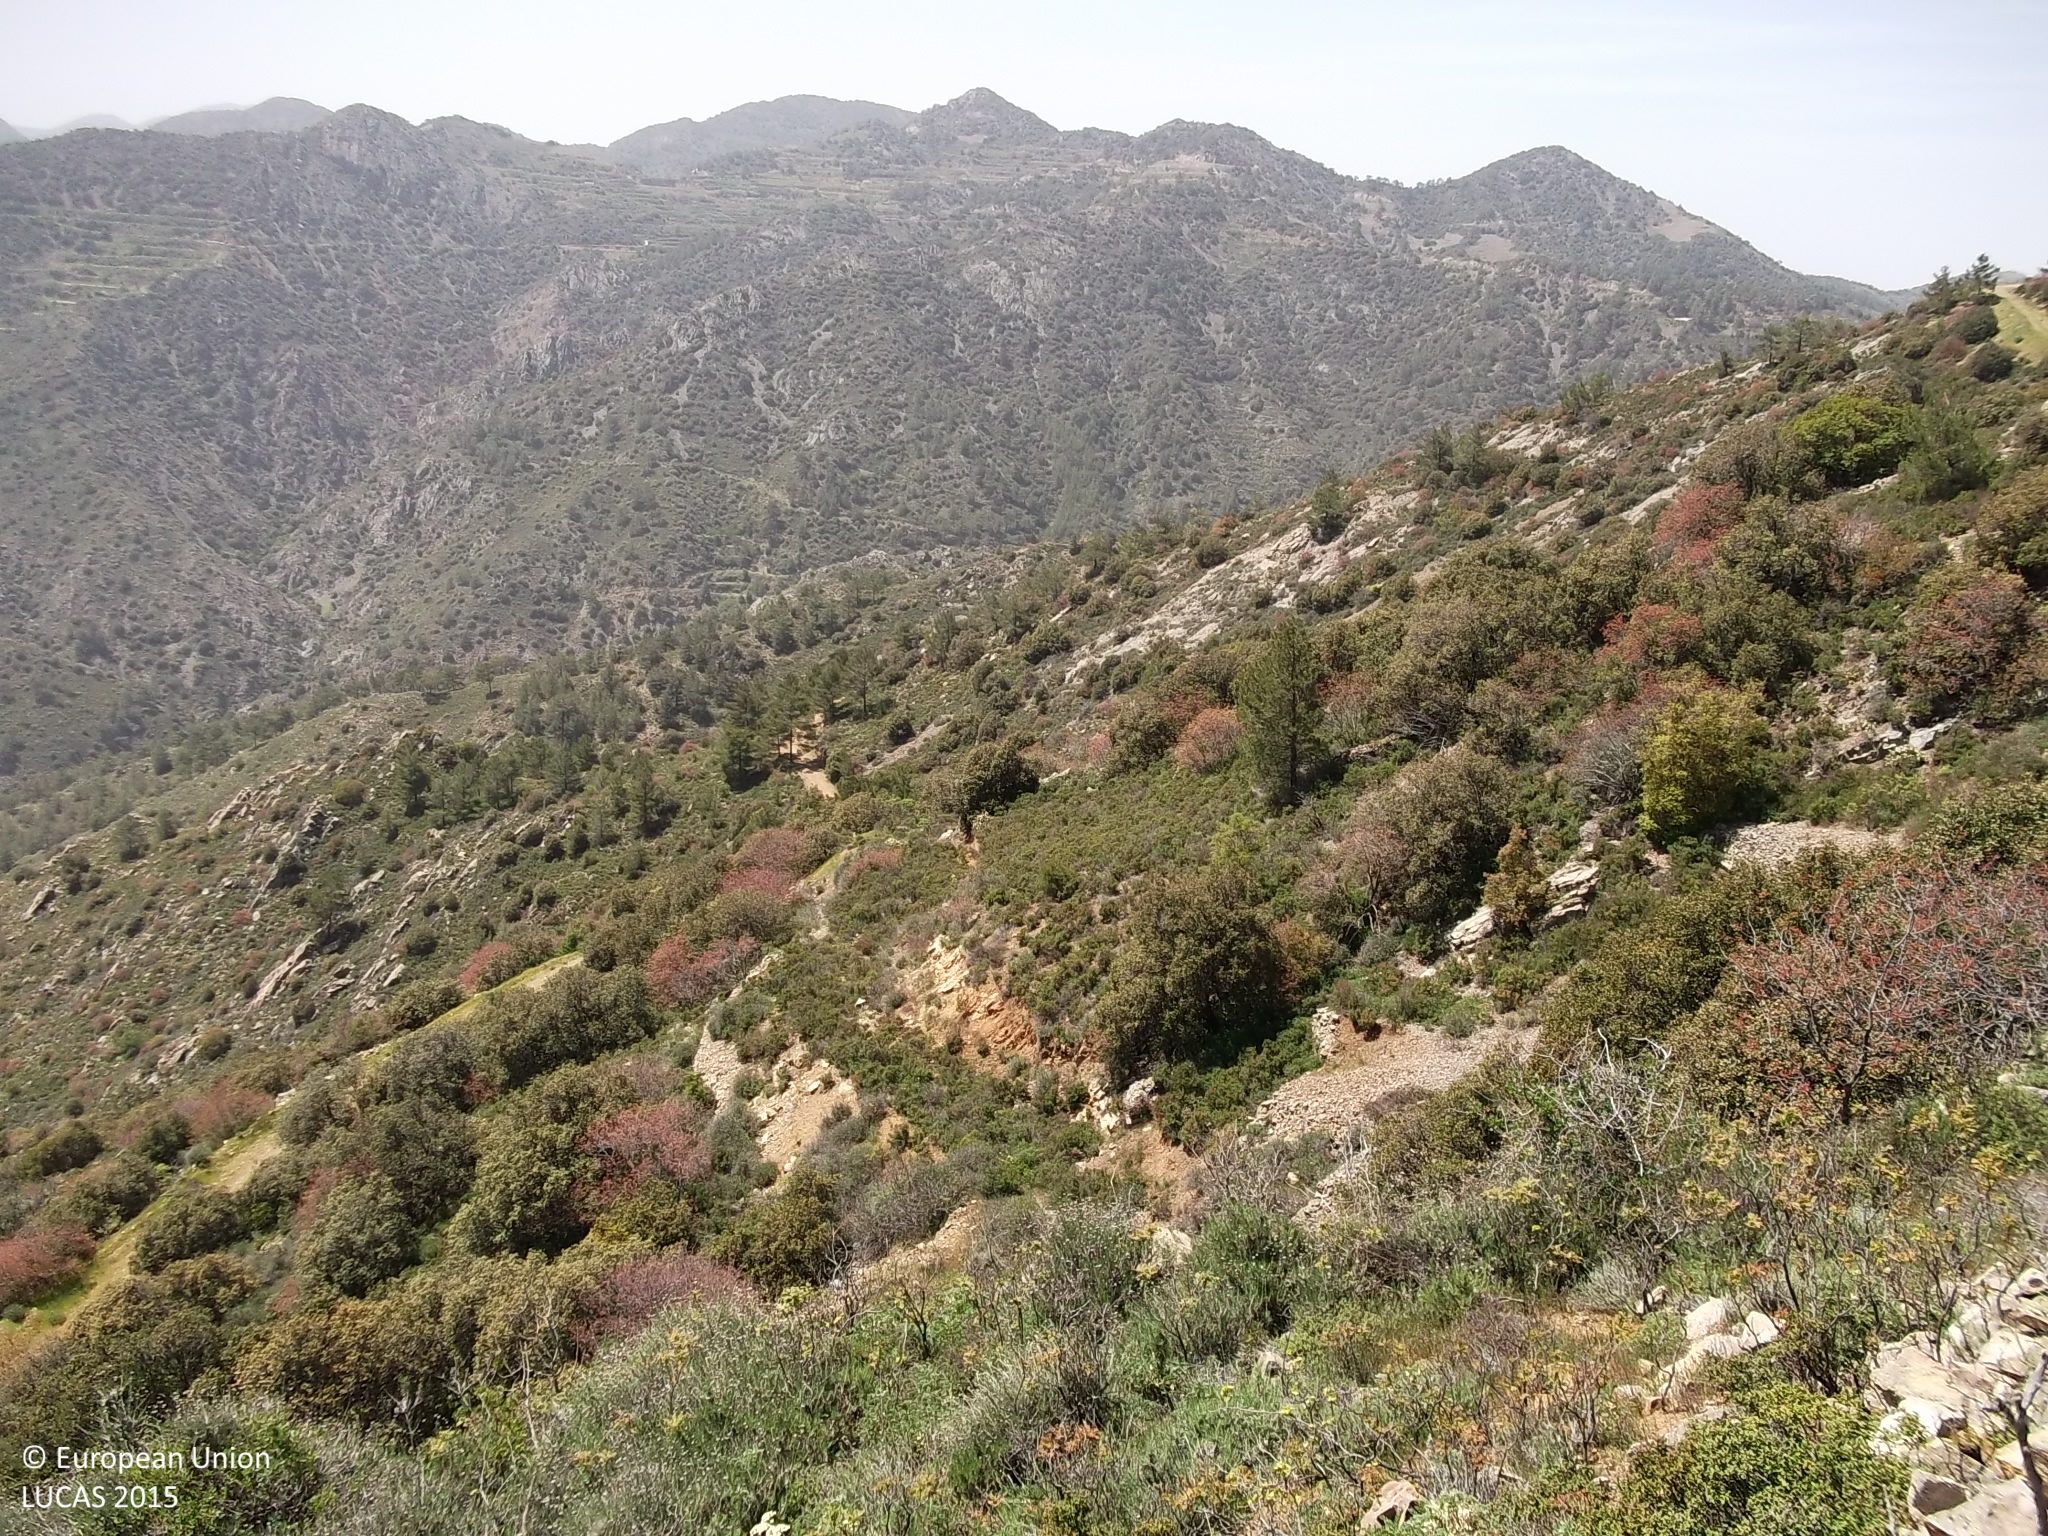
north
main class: Shrubland
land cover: Shrubland without tree cover
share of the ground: > 75 %
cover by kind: shrubs 75 %, consolidated bare surface 15 %, unconsolidated bare surface 10 %
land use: Semi-natural and natural areas not in use
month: April
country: CY
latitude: 34.8951
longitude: 33.1906
